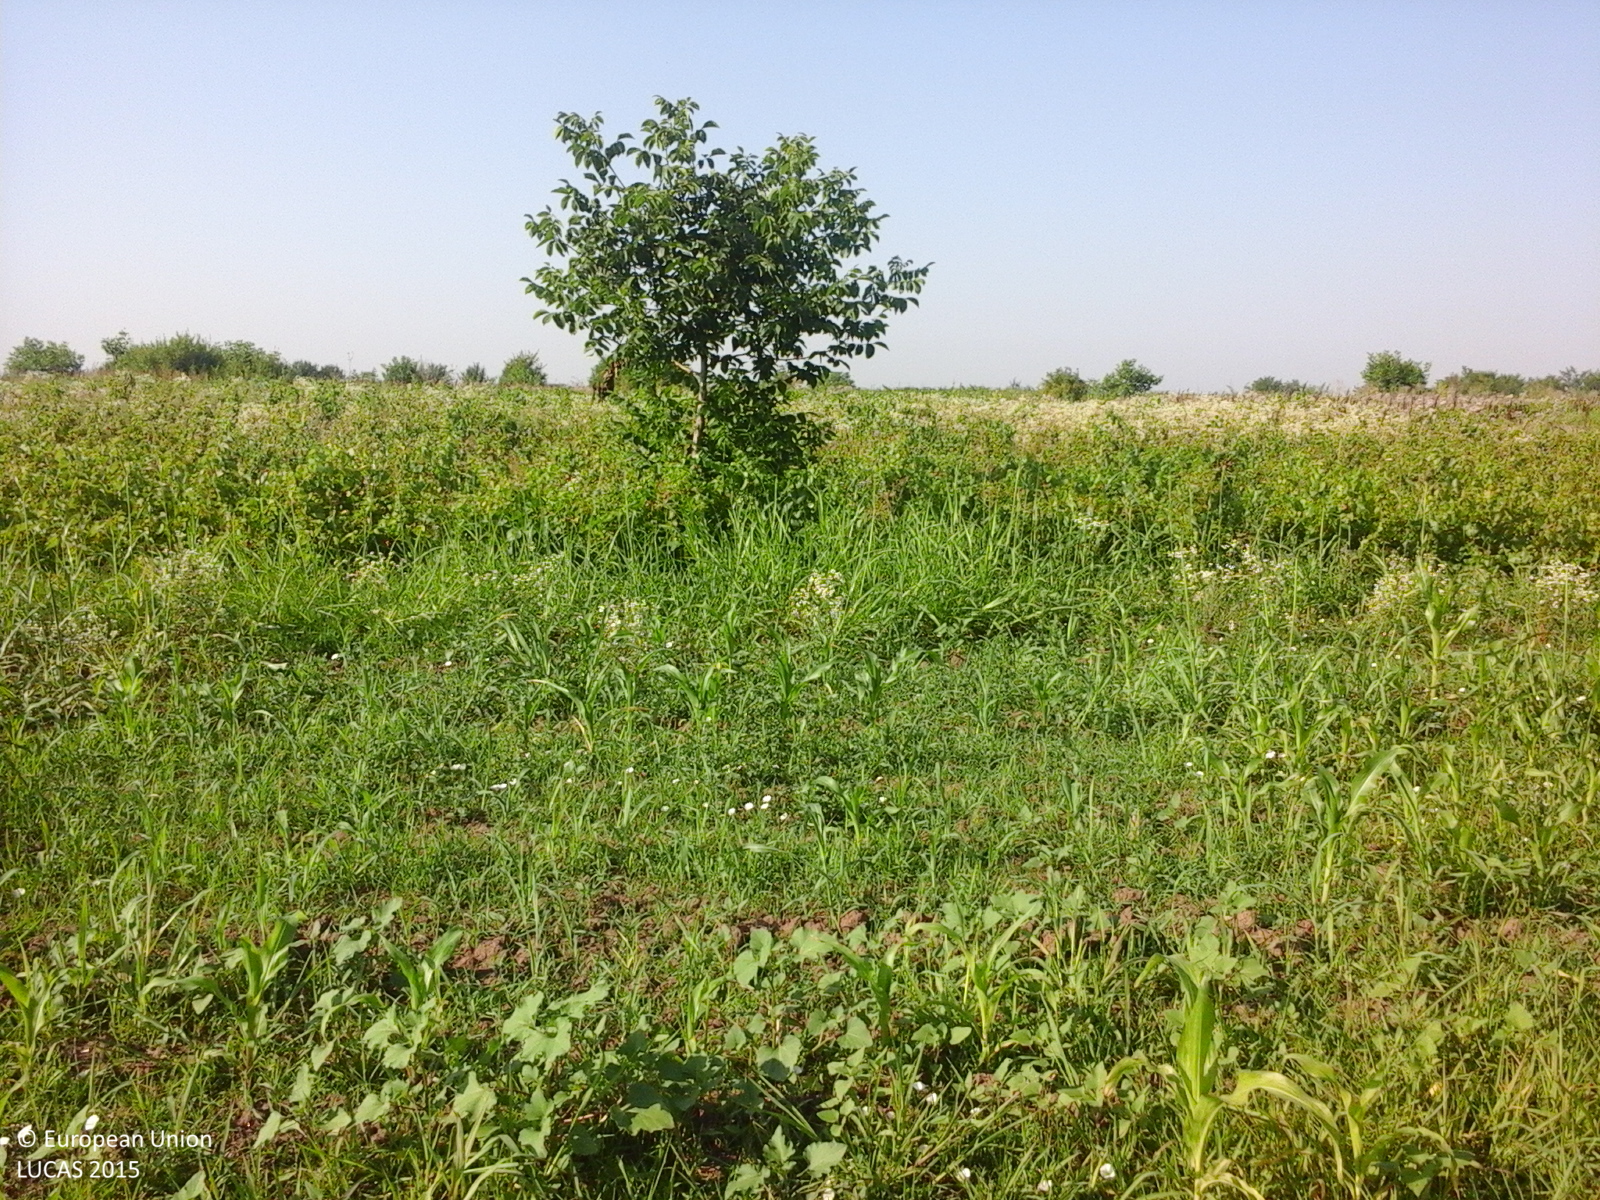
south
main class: Cropland
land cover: Maize
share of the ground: 25 - 50 %
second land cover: Spontaneously vegetated surfaces
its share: 50 - 75 %
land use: Agriculture (excluding fallow land and kitchen gardens)
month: July
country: RO
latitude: 44.1182
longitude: 25.3419
